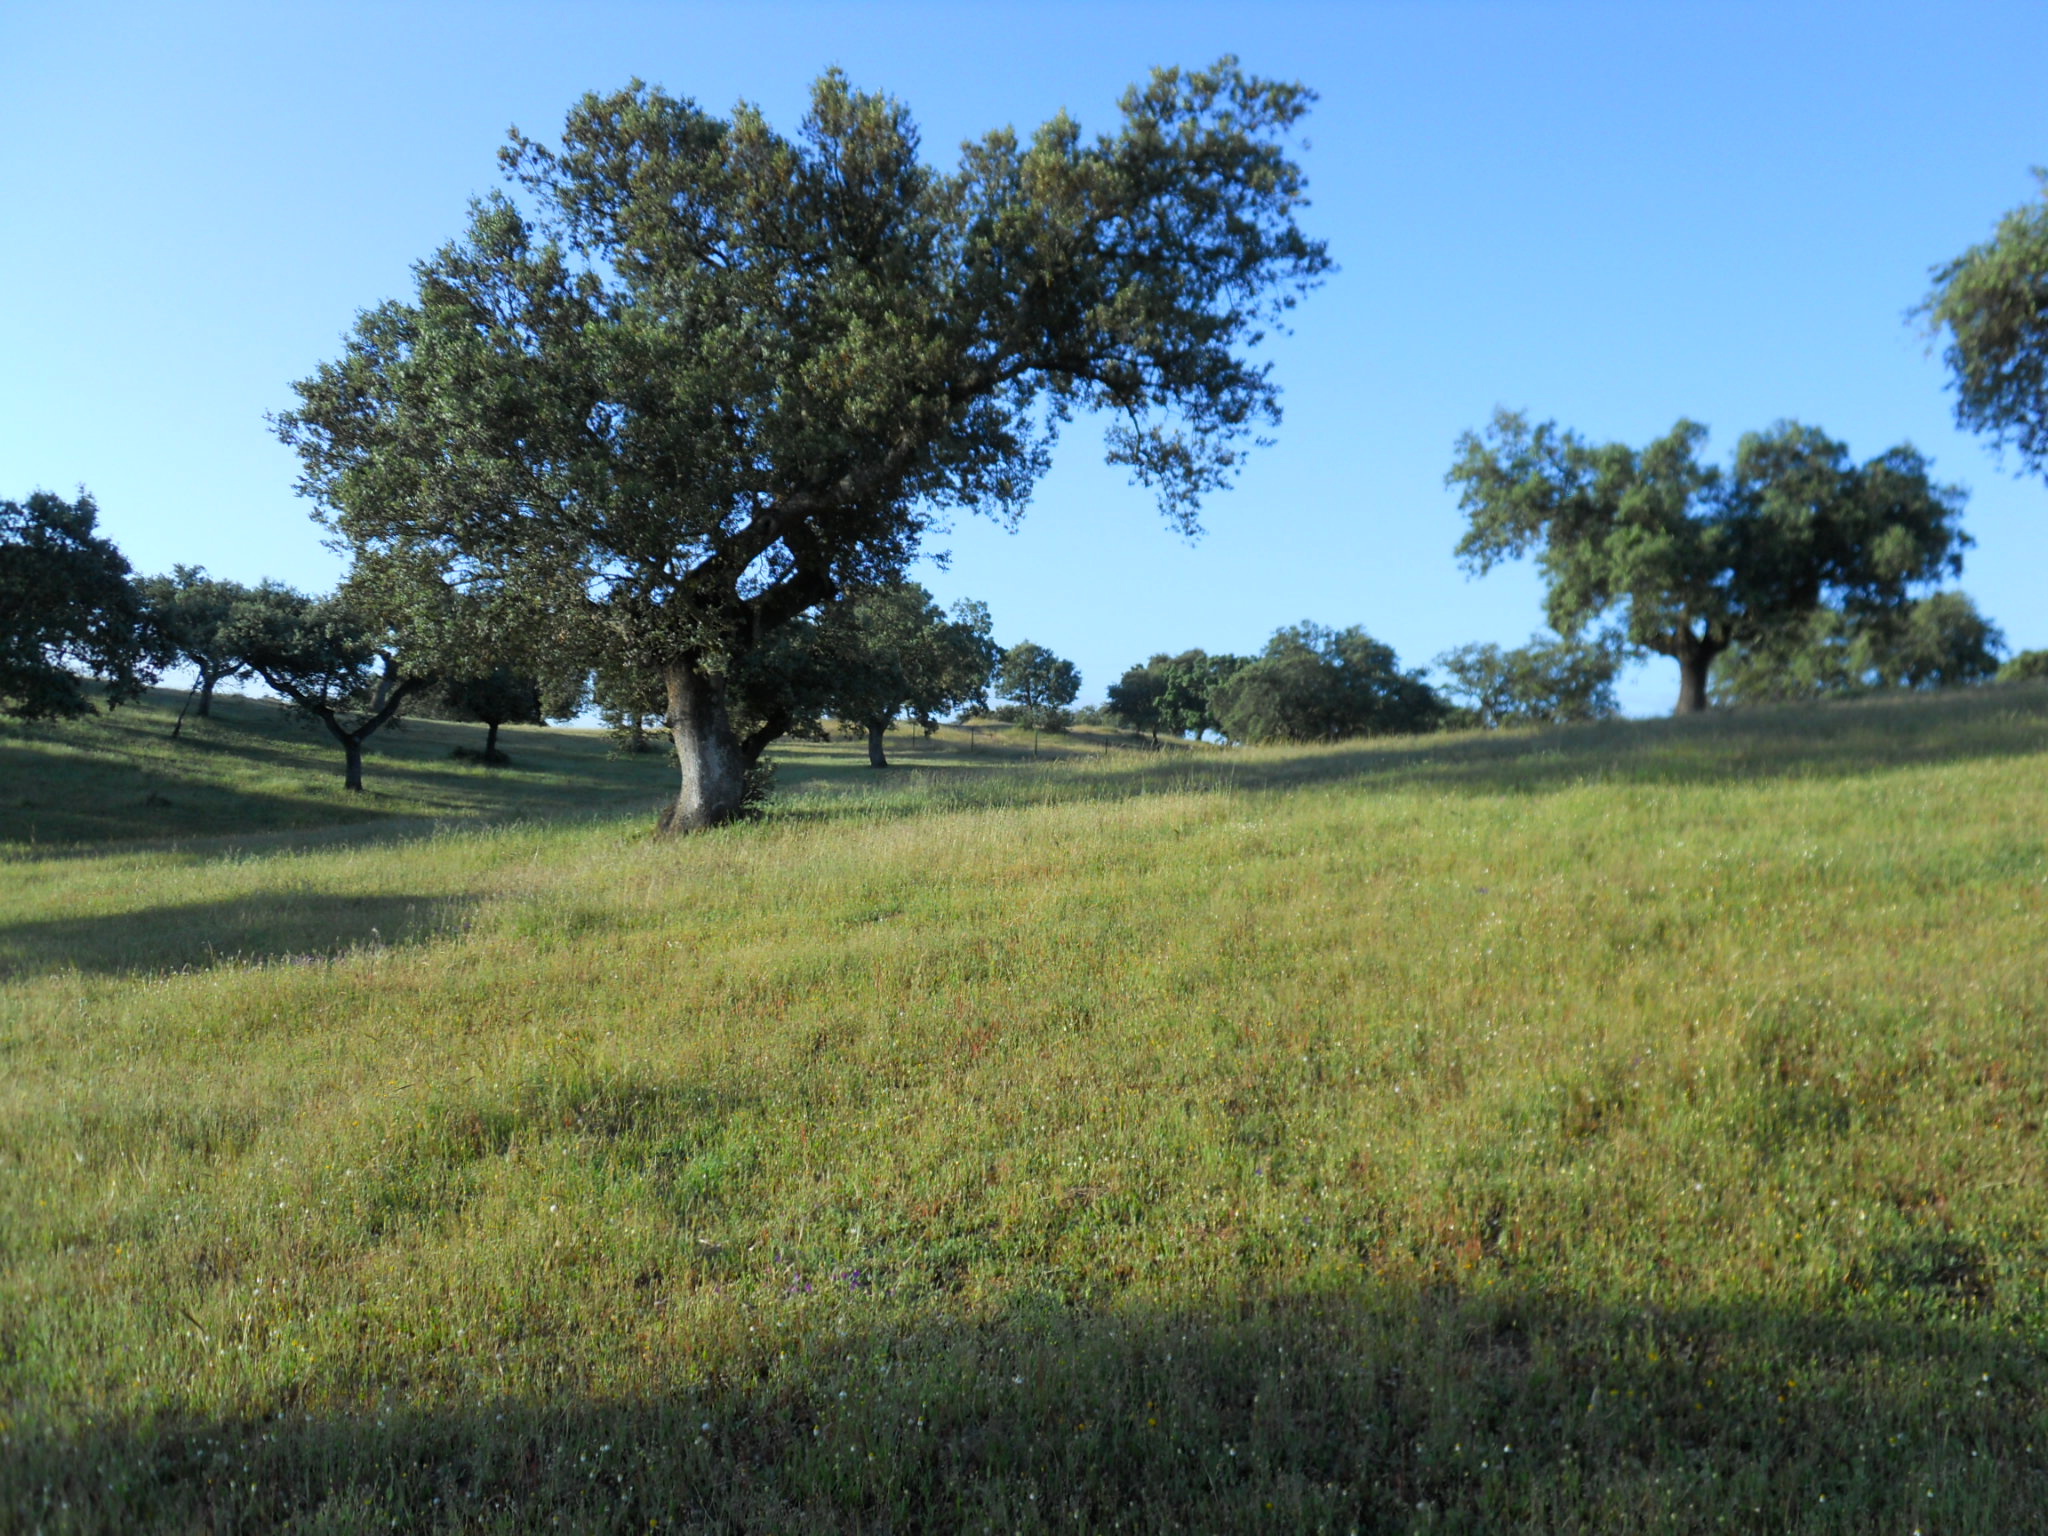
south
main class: Woodland
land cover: Broadleaved woodland
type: broadleaved evergreen forest
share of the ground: 25 - 50 %
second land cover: Grassland without tree/shrub cover
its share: > 75 %
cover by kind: herbaceous plants 70 %, broadleaved forest trees 30 %
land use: Forestry
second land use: Agriculture (excluding fallow land and kitchen gardens)
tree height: > 5 m
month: May
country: ES
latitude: 39.1208
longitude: -6.9019
